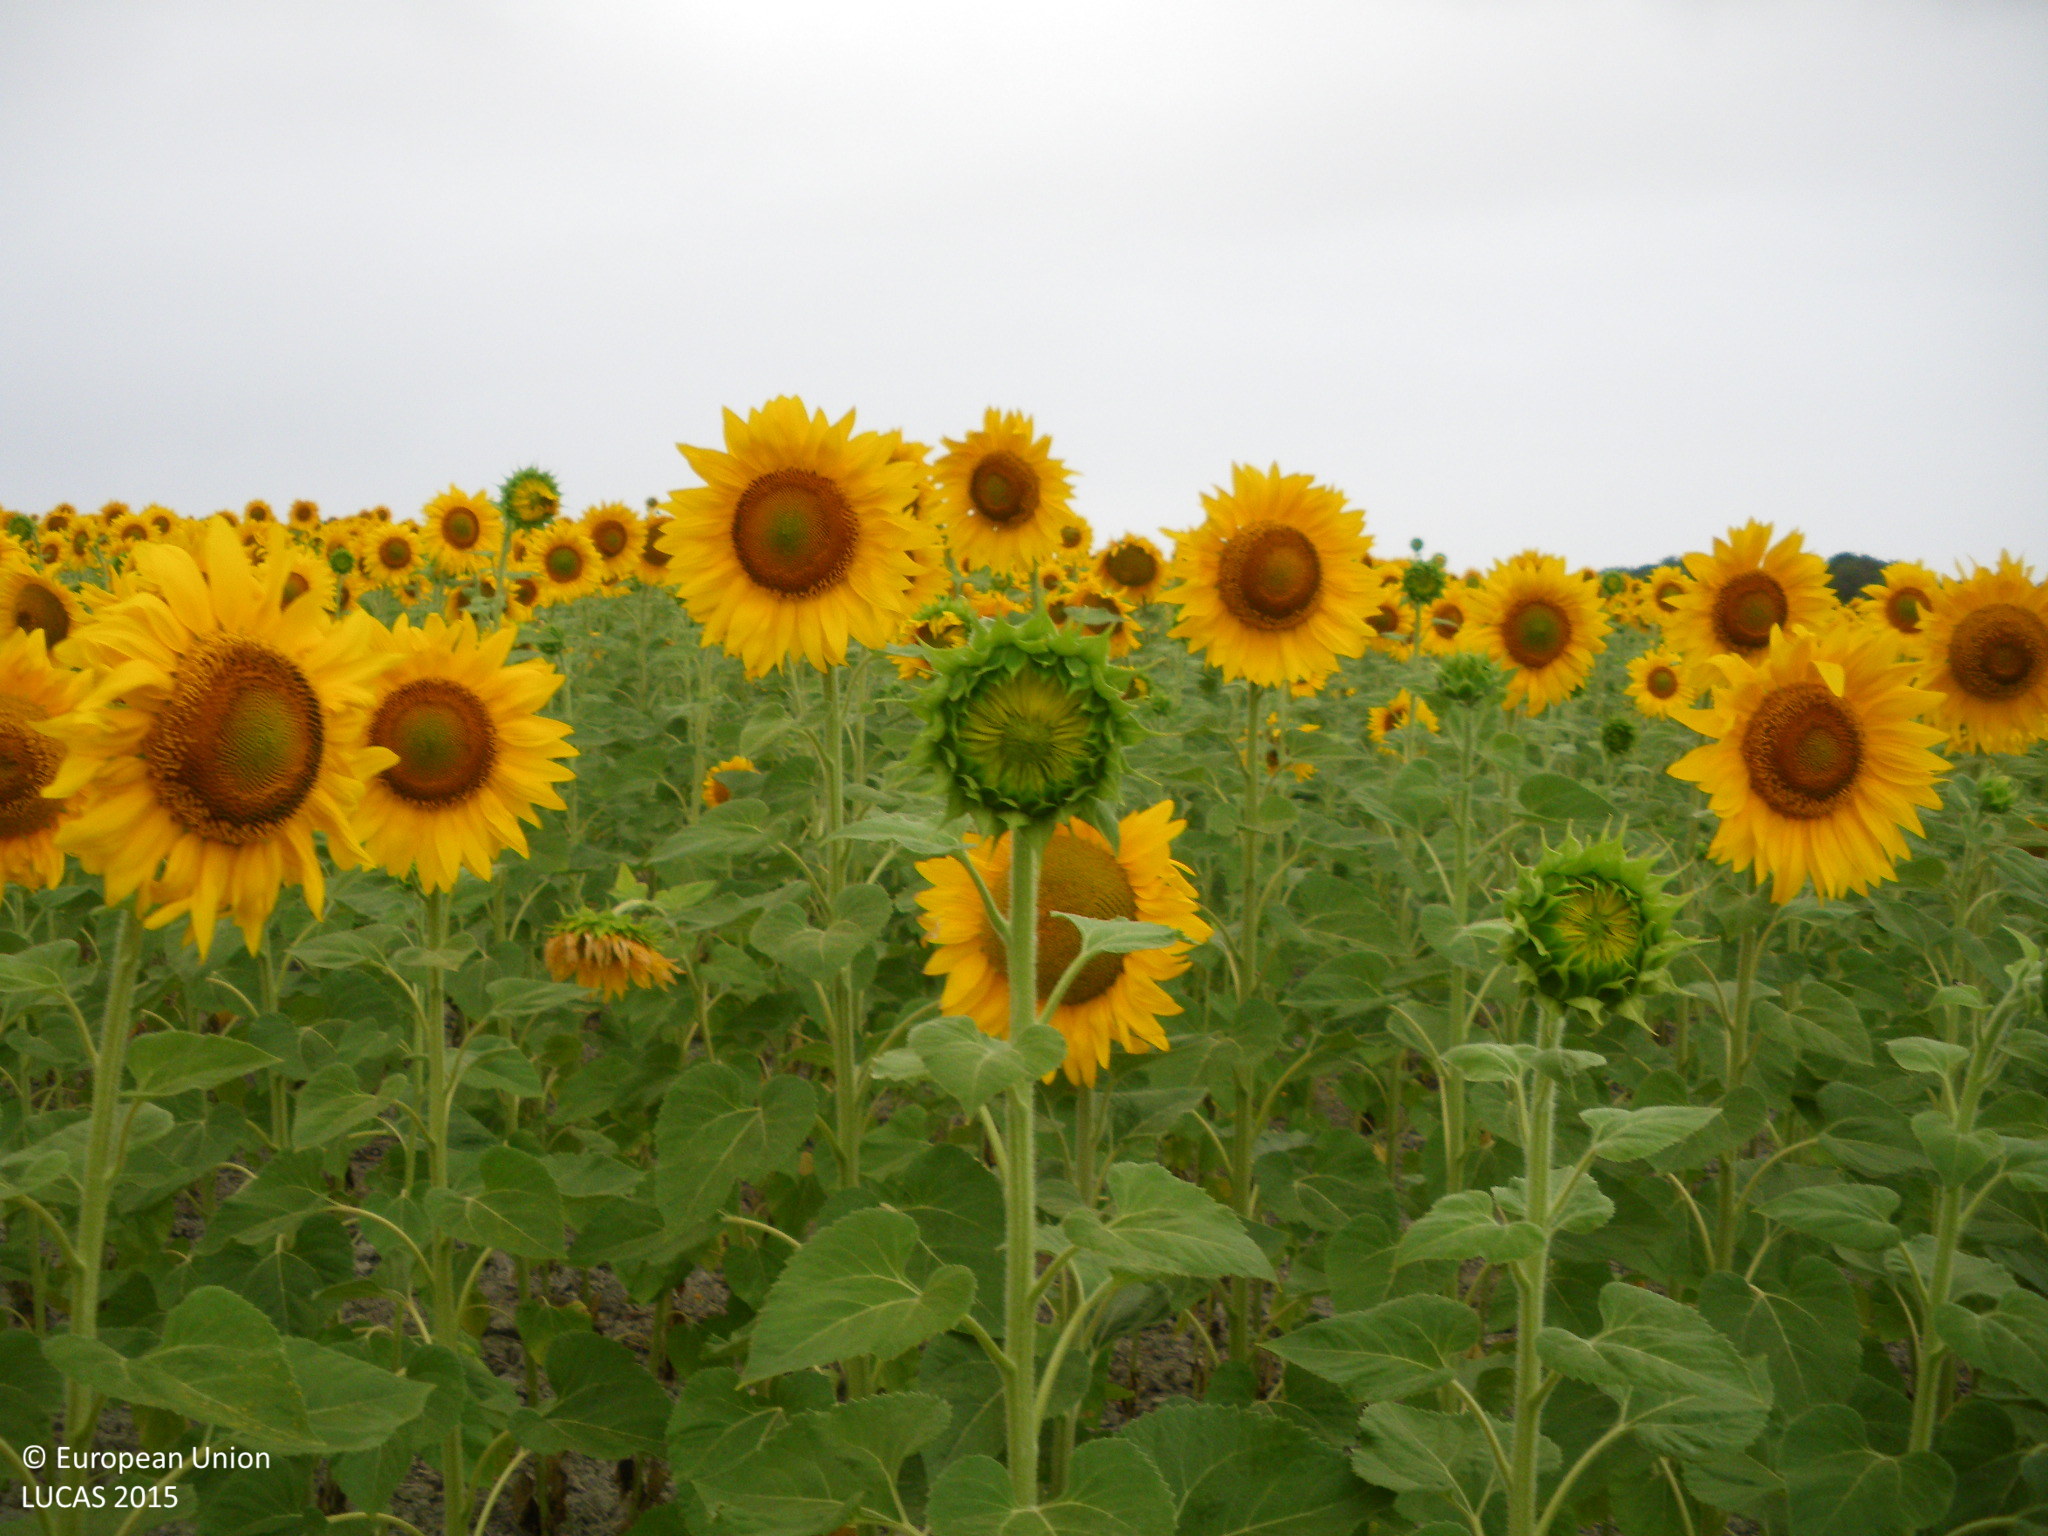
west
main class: Cropland
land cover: Sunflower
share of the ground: > 75 %
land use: Agriculture (excluding fallow land and kitchen gardens)
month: June
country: ES
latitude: 36.6783
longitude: -6.0005
